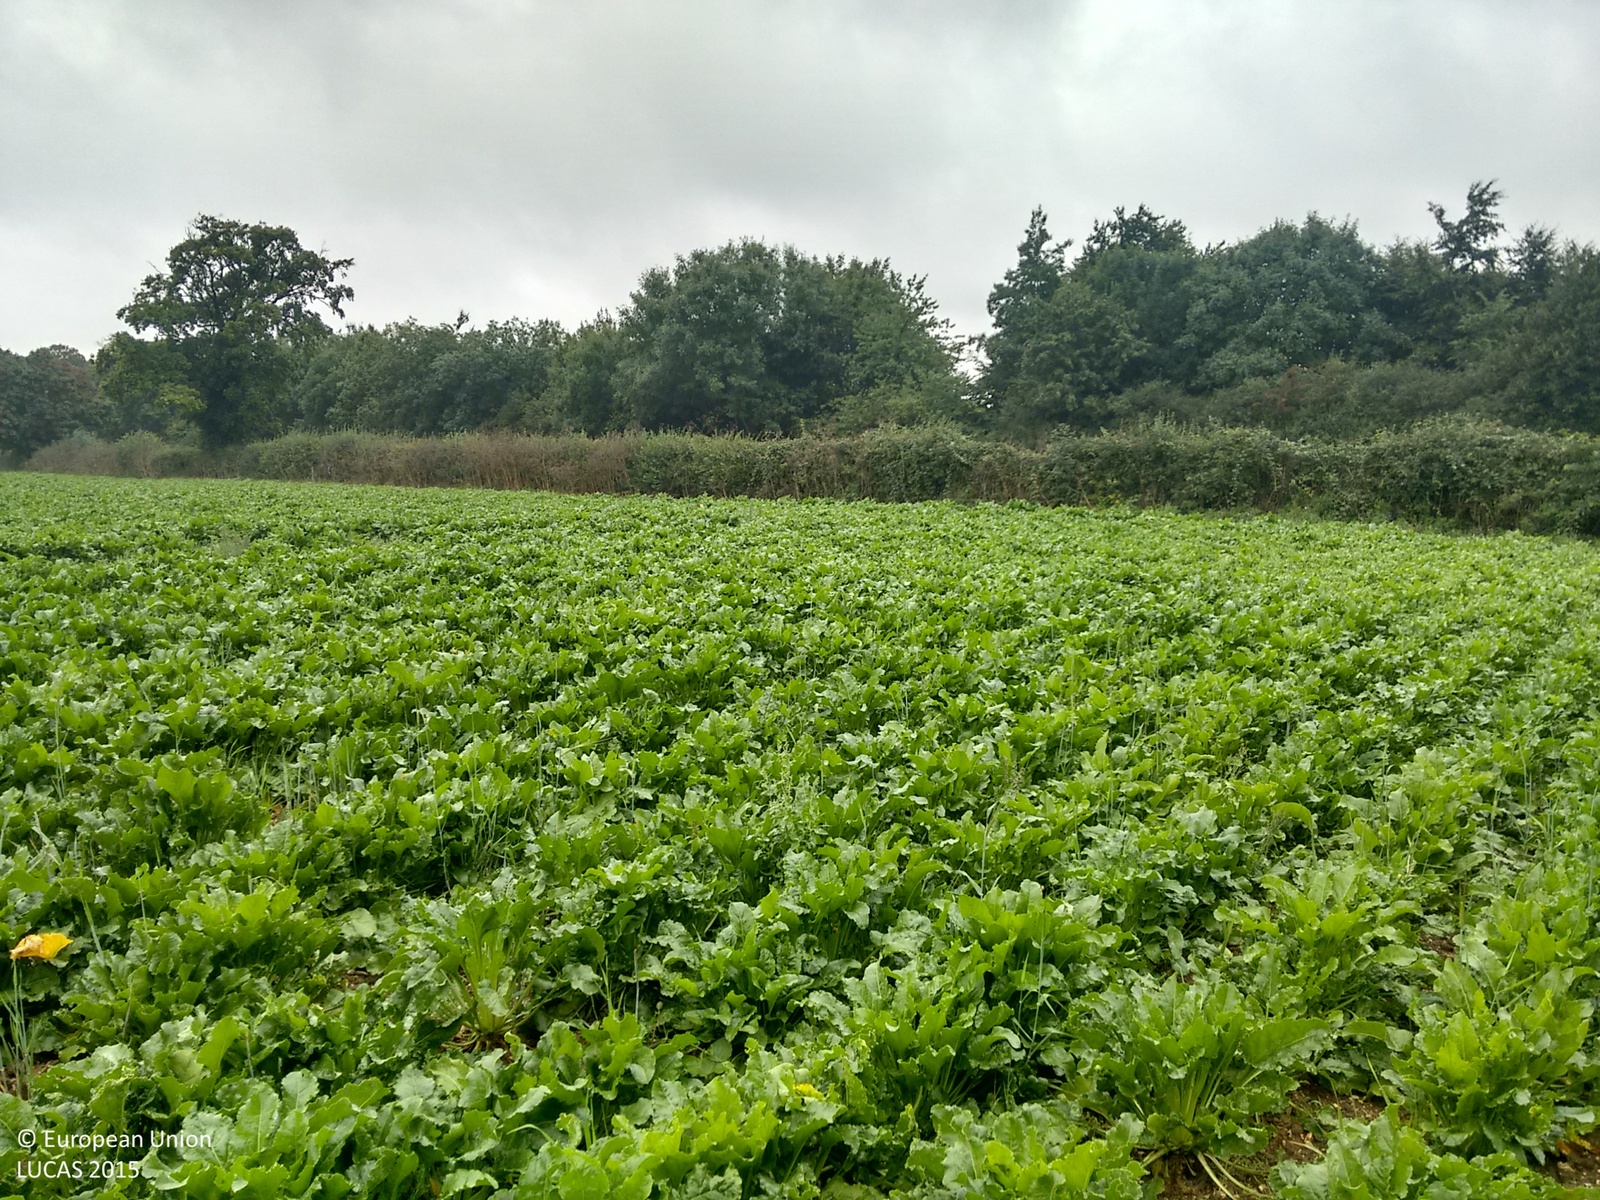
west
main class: Cropland
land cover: Sugar beet
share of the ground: > 75 %
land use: Agriculture (excluding fallow land and kitchen gardens)
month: September
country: GB
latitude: 52.2192
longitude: 0.3540
